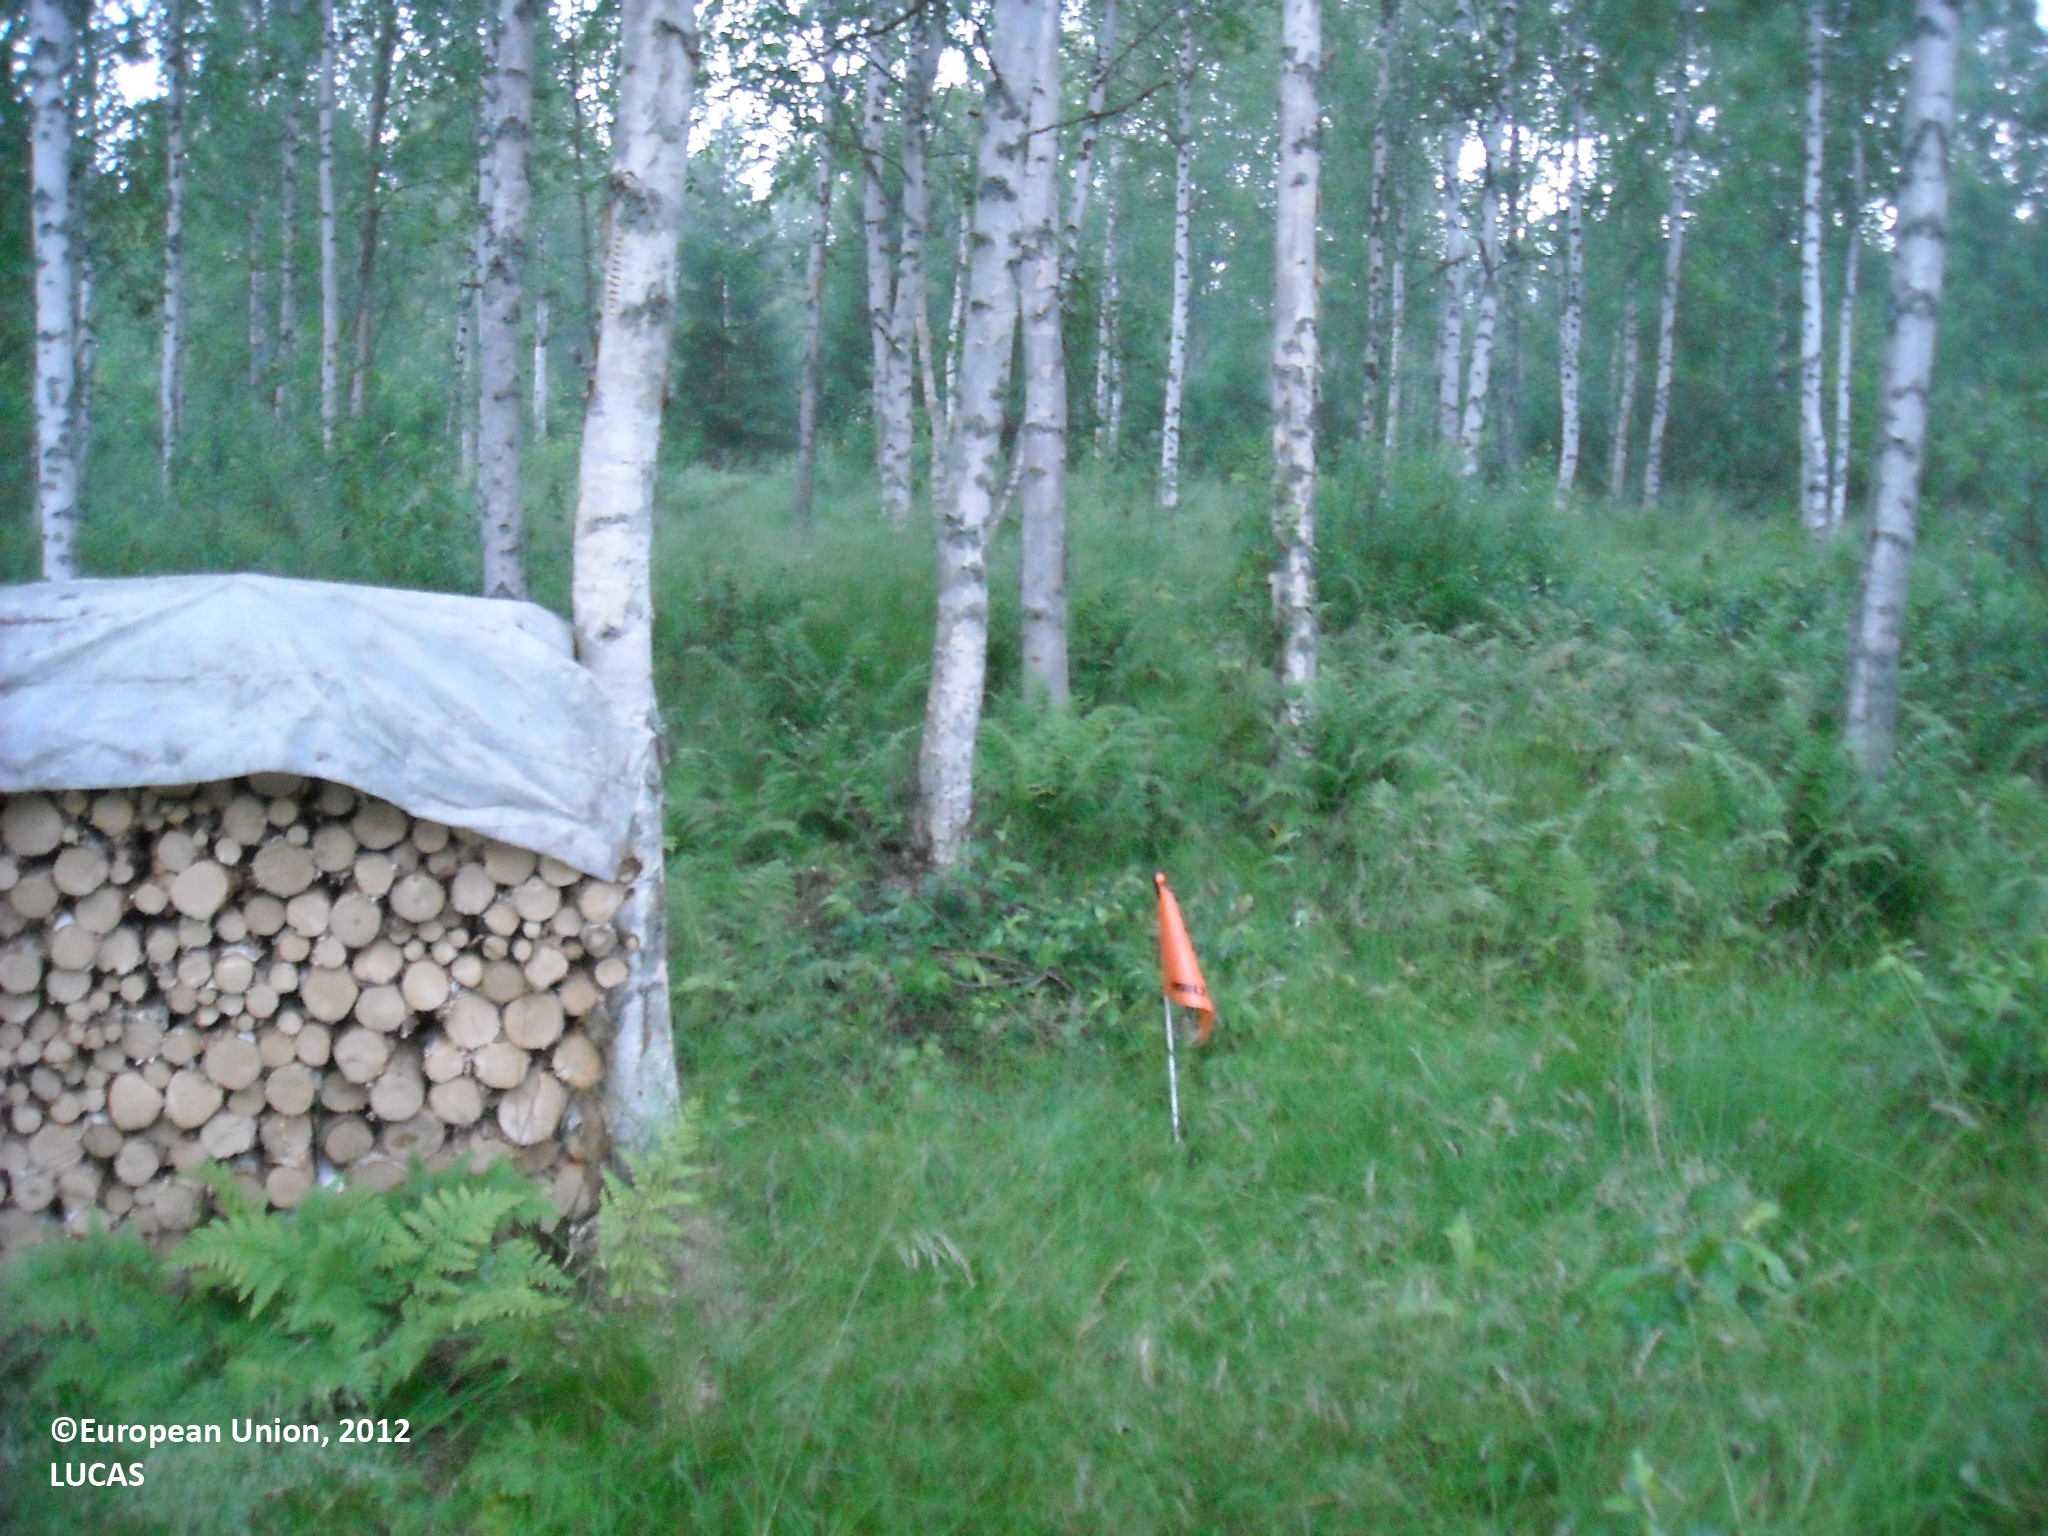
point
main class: Woodland
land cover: Broadleaved woodland
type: boreal forest
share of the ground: 50 - 75 %
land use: Forestry
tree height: > 5 m
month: July
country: FI
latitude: 64.8567
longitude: 26.7166
